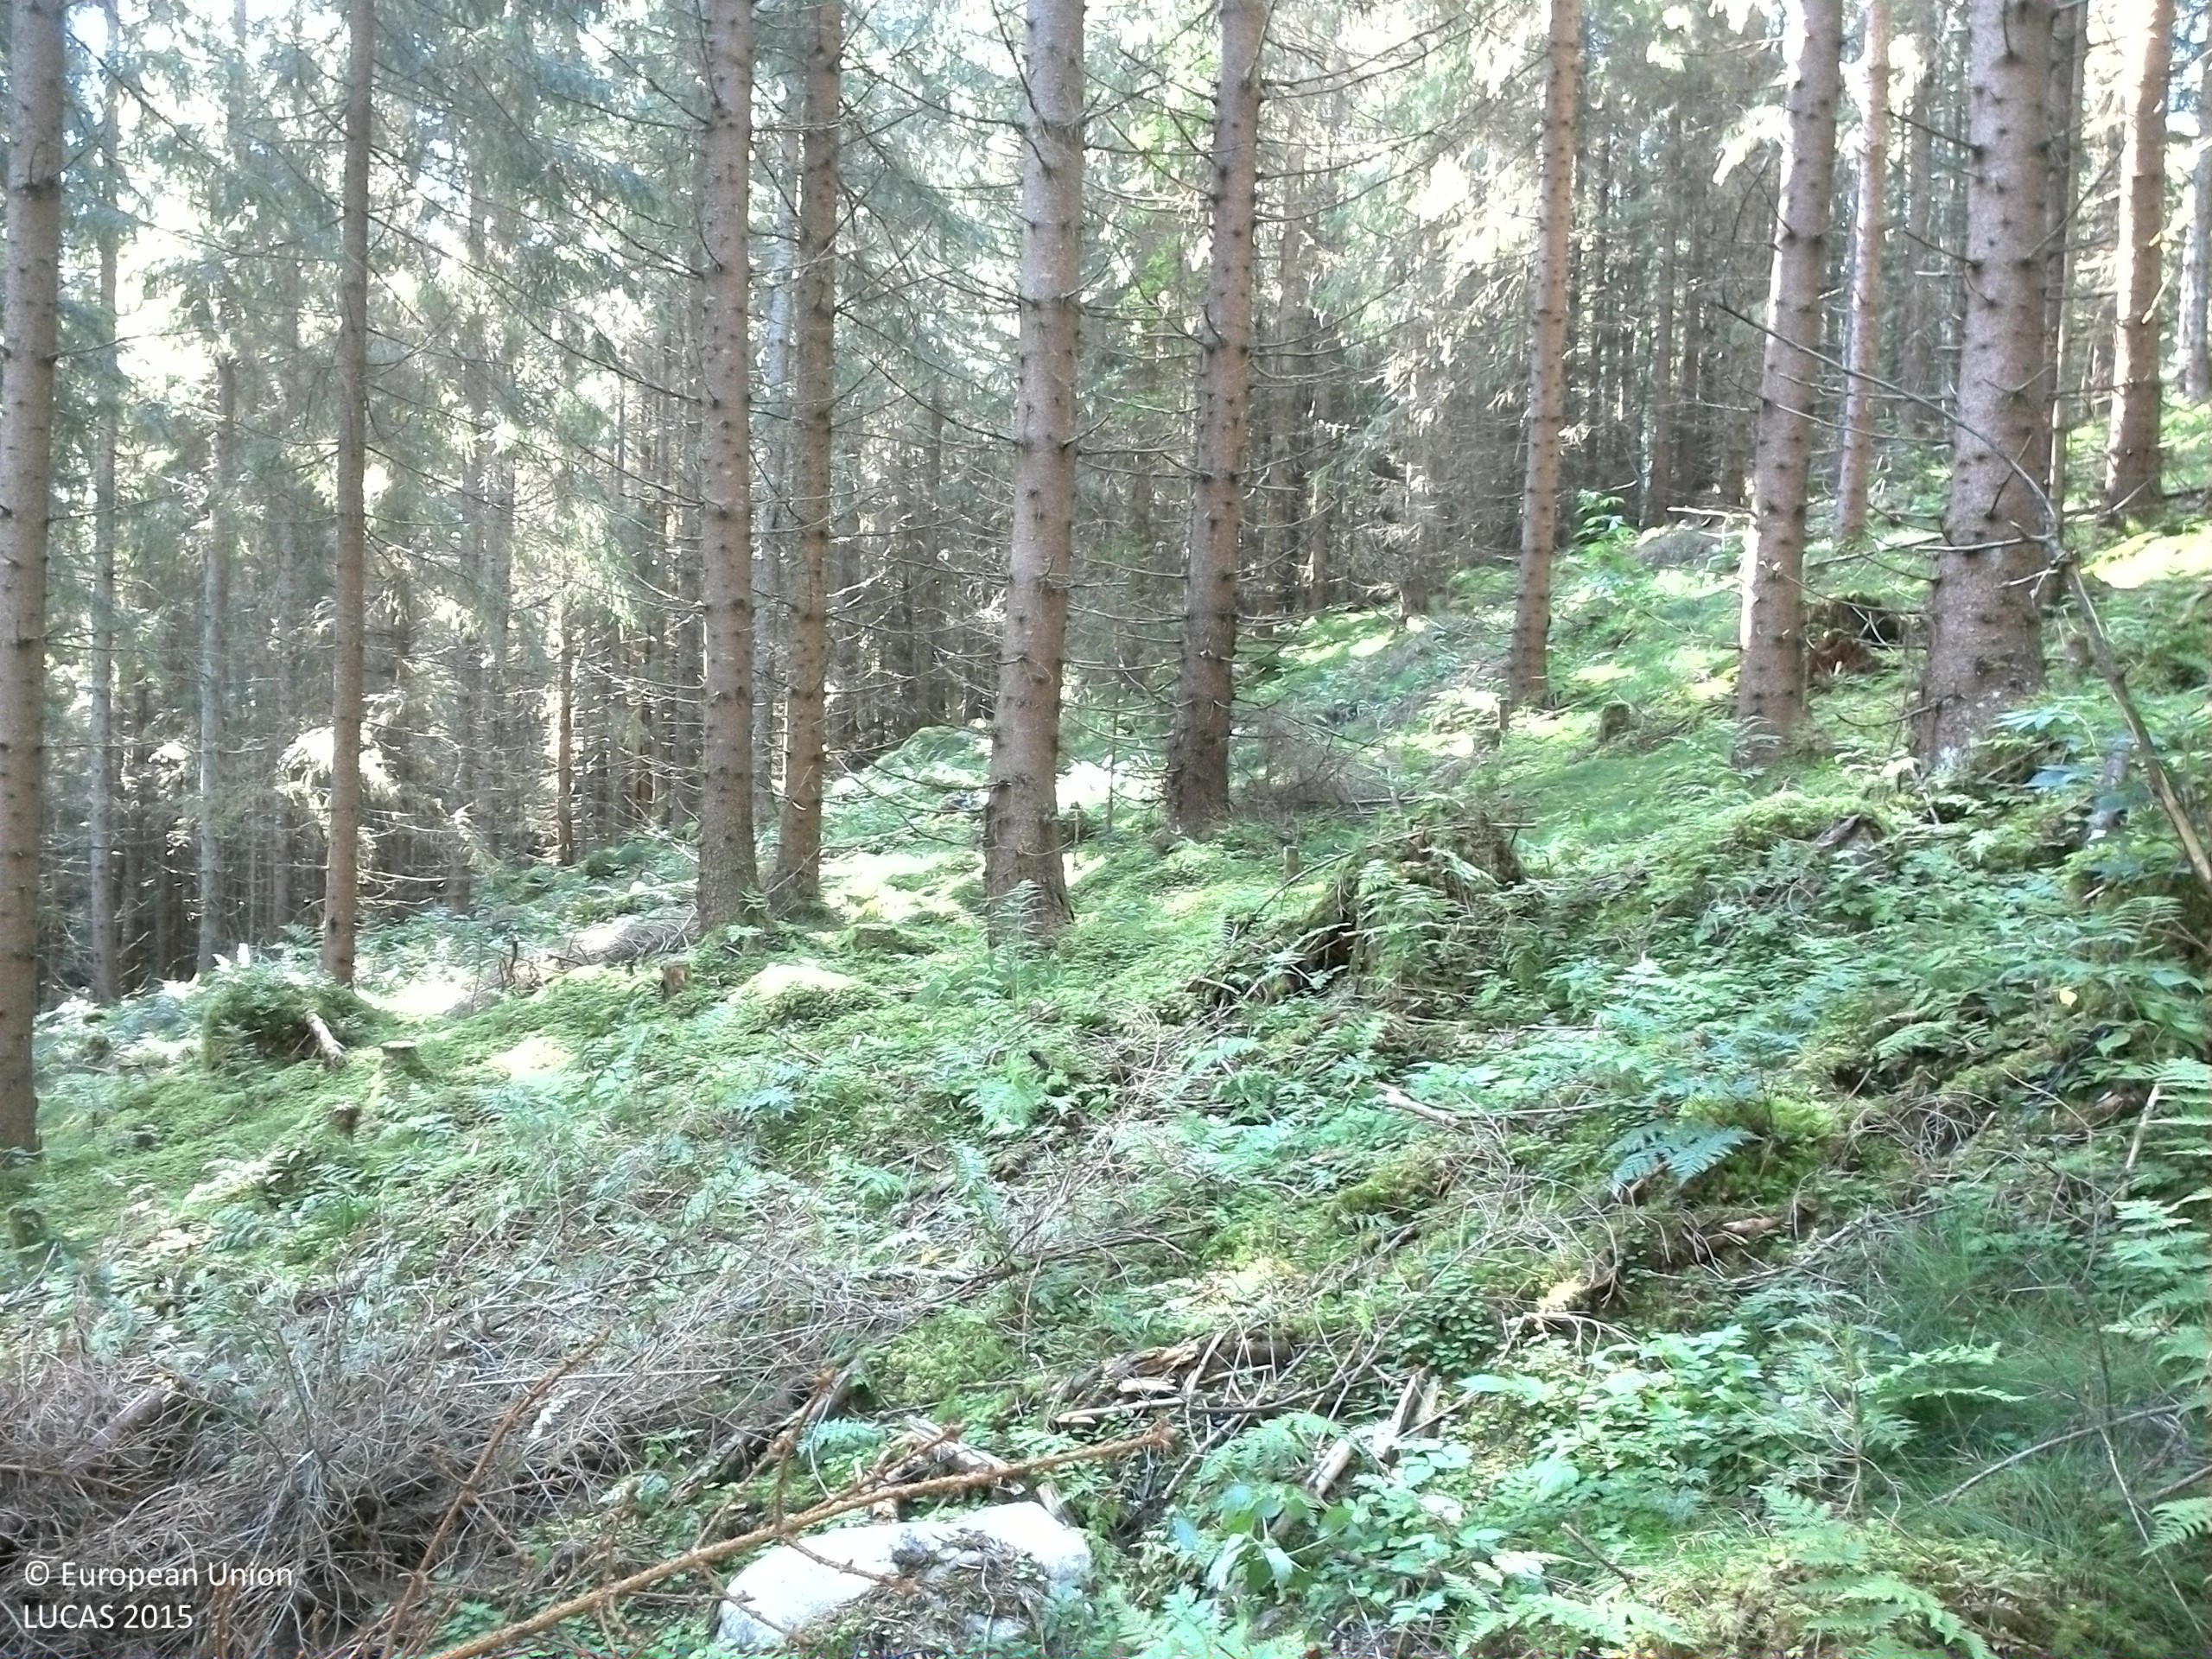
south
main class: Woodland
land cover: Spruce dominated coniferous woodland
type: boreal forest
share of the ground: 50 - 75 %
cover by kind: coniferous forest trees 70 %, lichens and mosses 15 %, shrubs 10 %, herbaceous plants 5 %
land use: Forestry
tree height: > 5 m
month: September
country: SE
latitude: 59.8667
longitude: 13.5092
